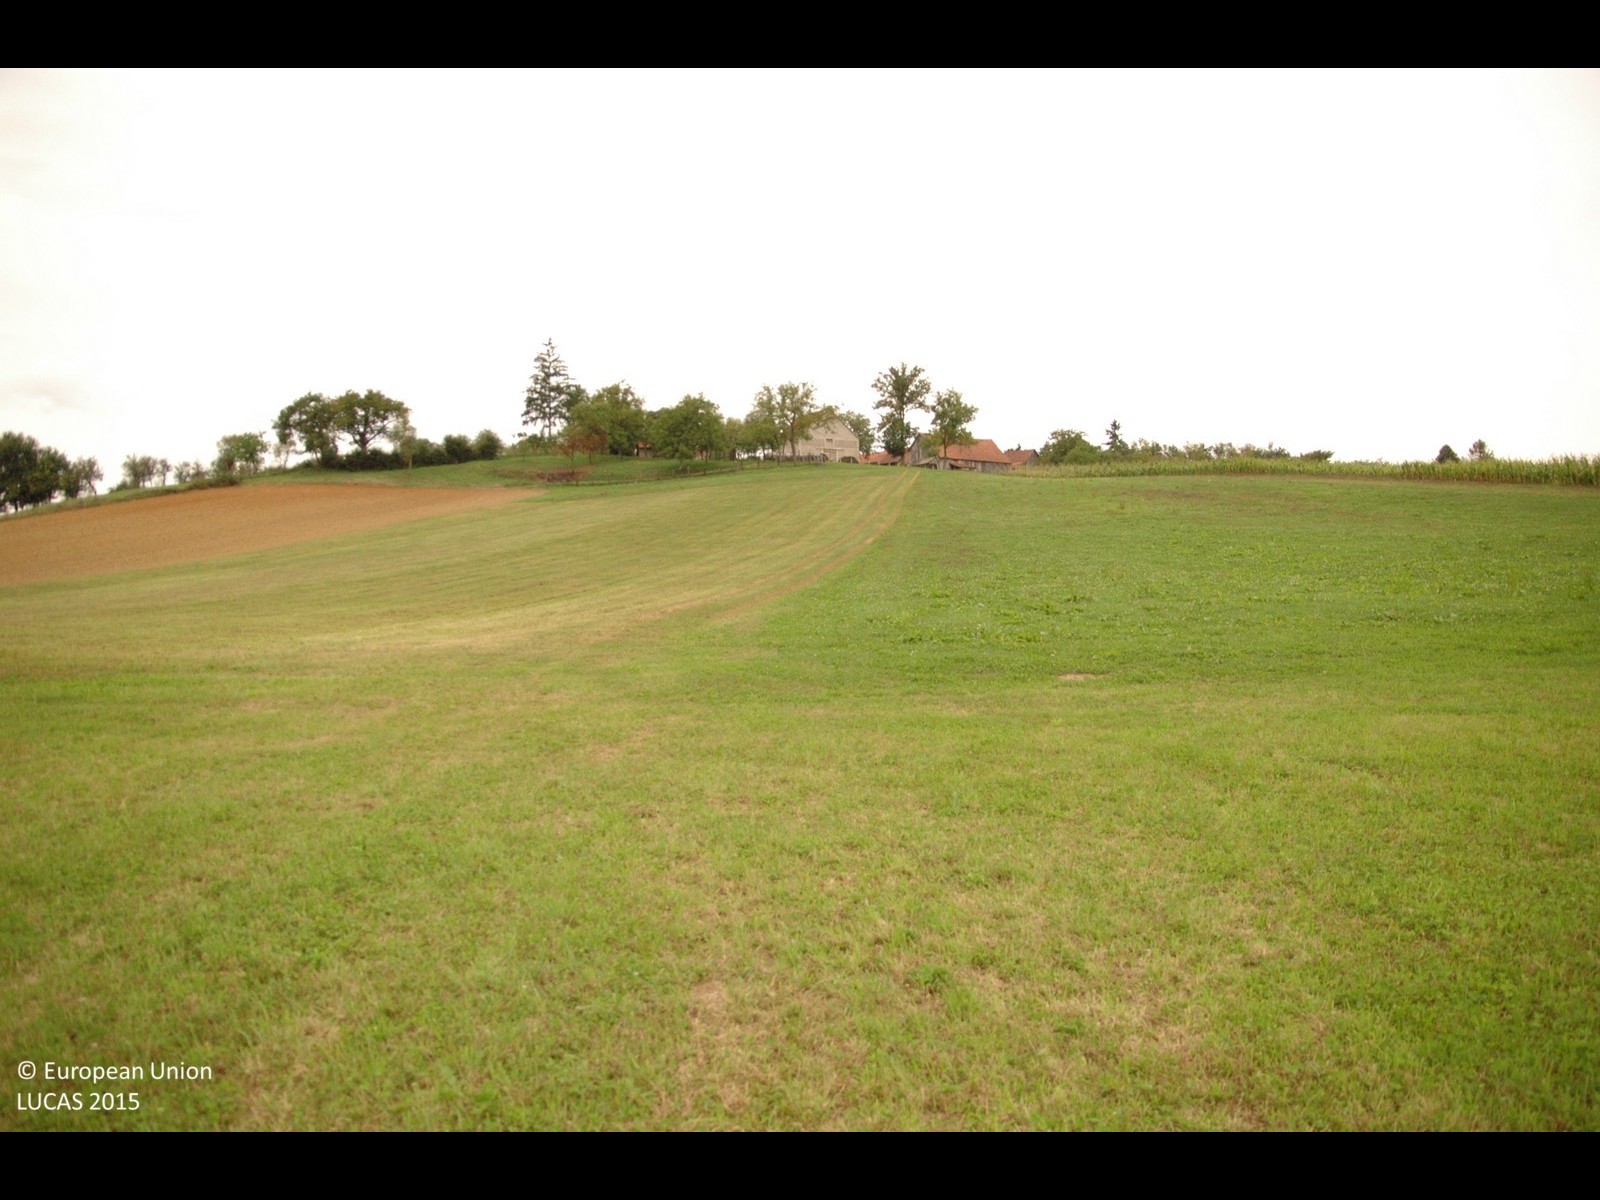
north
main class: Grassland
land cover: Grassland without tree/shrub cover
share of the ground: > 75 %
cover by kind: herbaceous plants 100 %
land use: Agriculture (excluding fallow land and kitchen gardens)
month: September
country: HR
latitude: 46.0649
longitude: 16.7618
